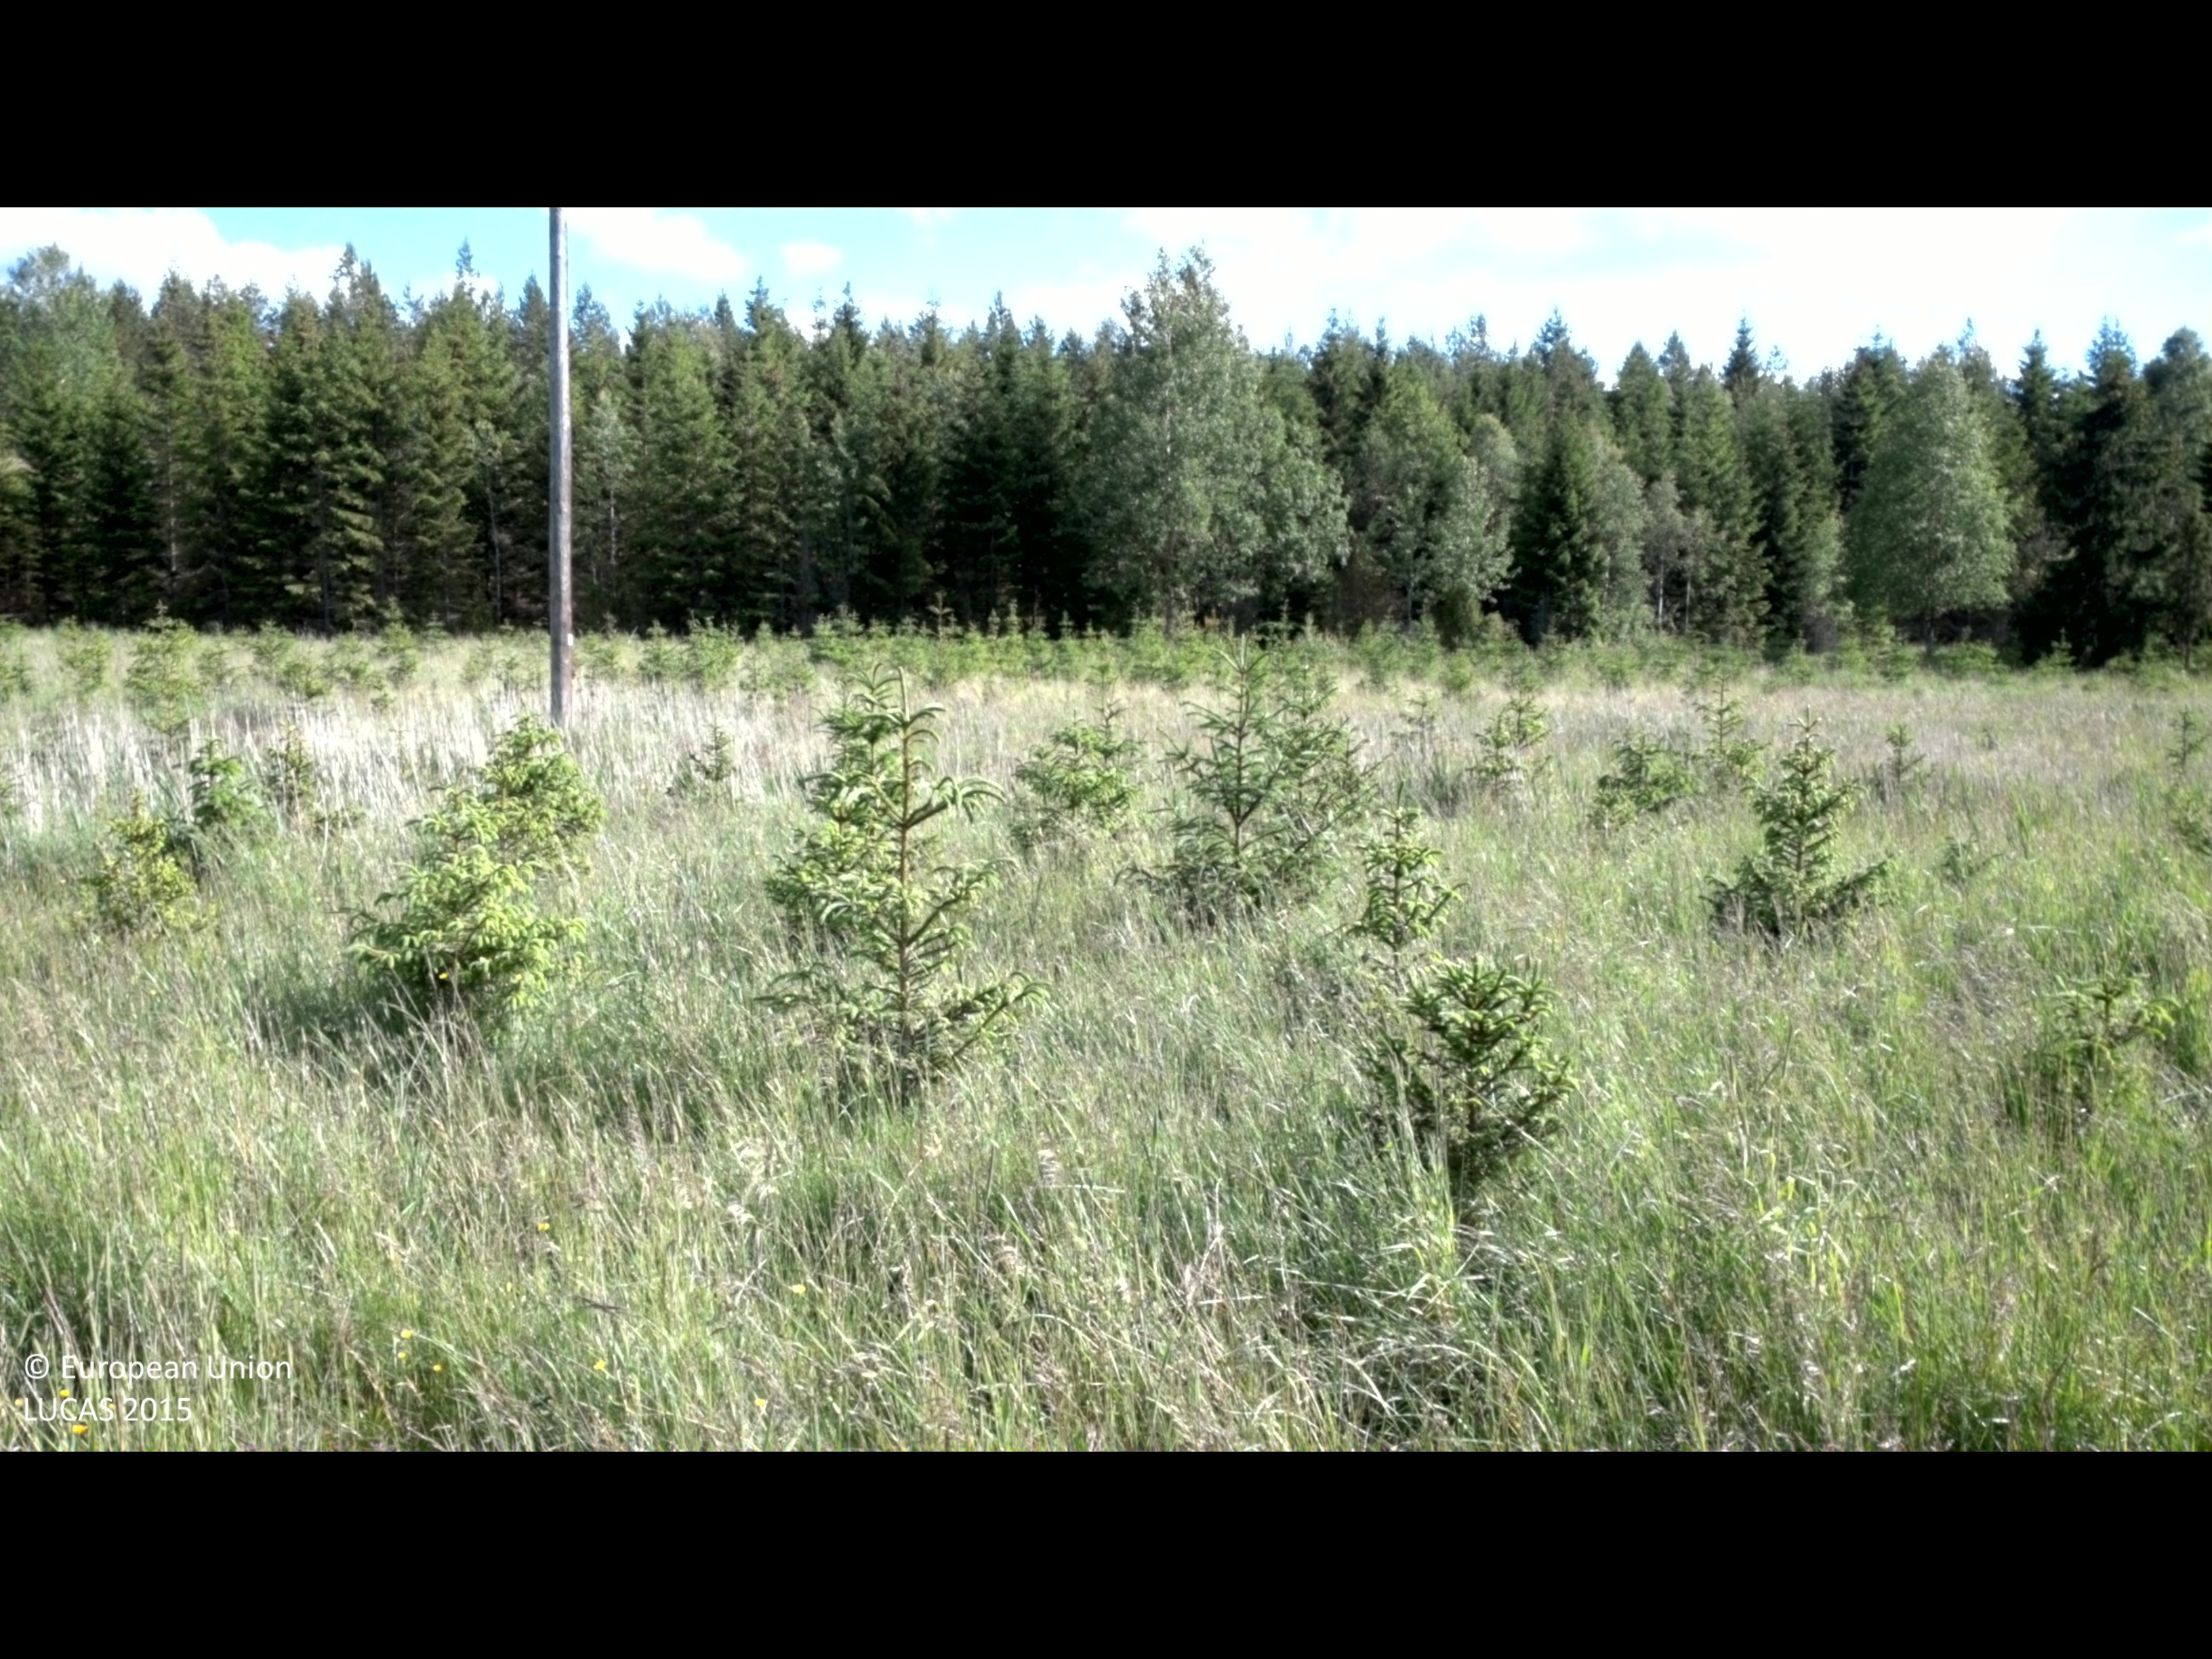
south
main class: Woodland
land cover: Spruce dominated coniferous woodland
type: boreal forest
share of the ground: < 10 %
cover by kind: herbaceous plants 90 %, coniferous forest trees 10 %
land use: Forestry
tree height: < 5 m
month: June
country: SE
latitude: 58.0936
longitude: 16.5965
